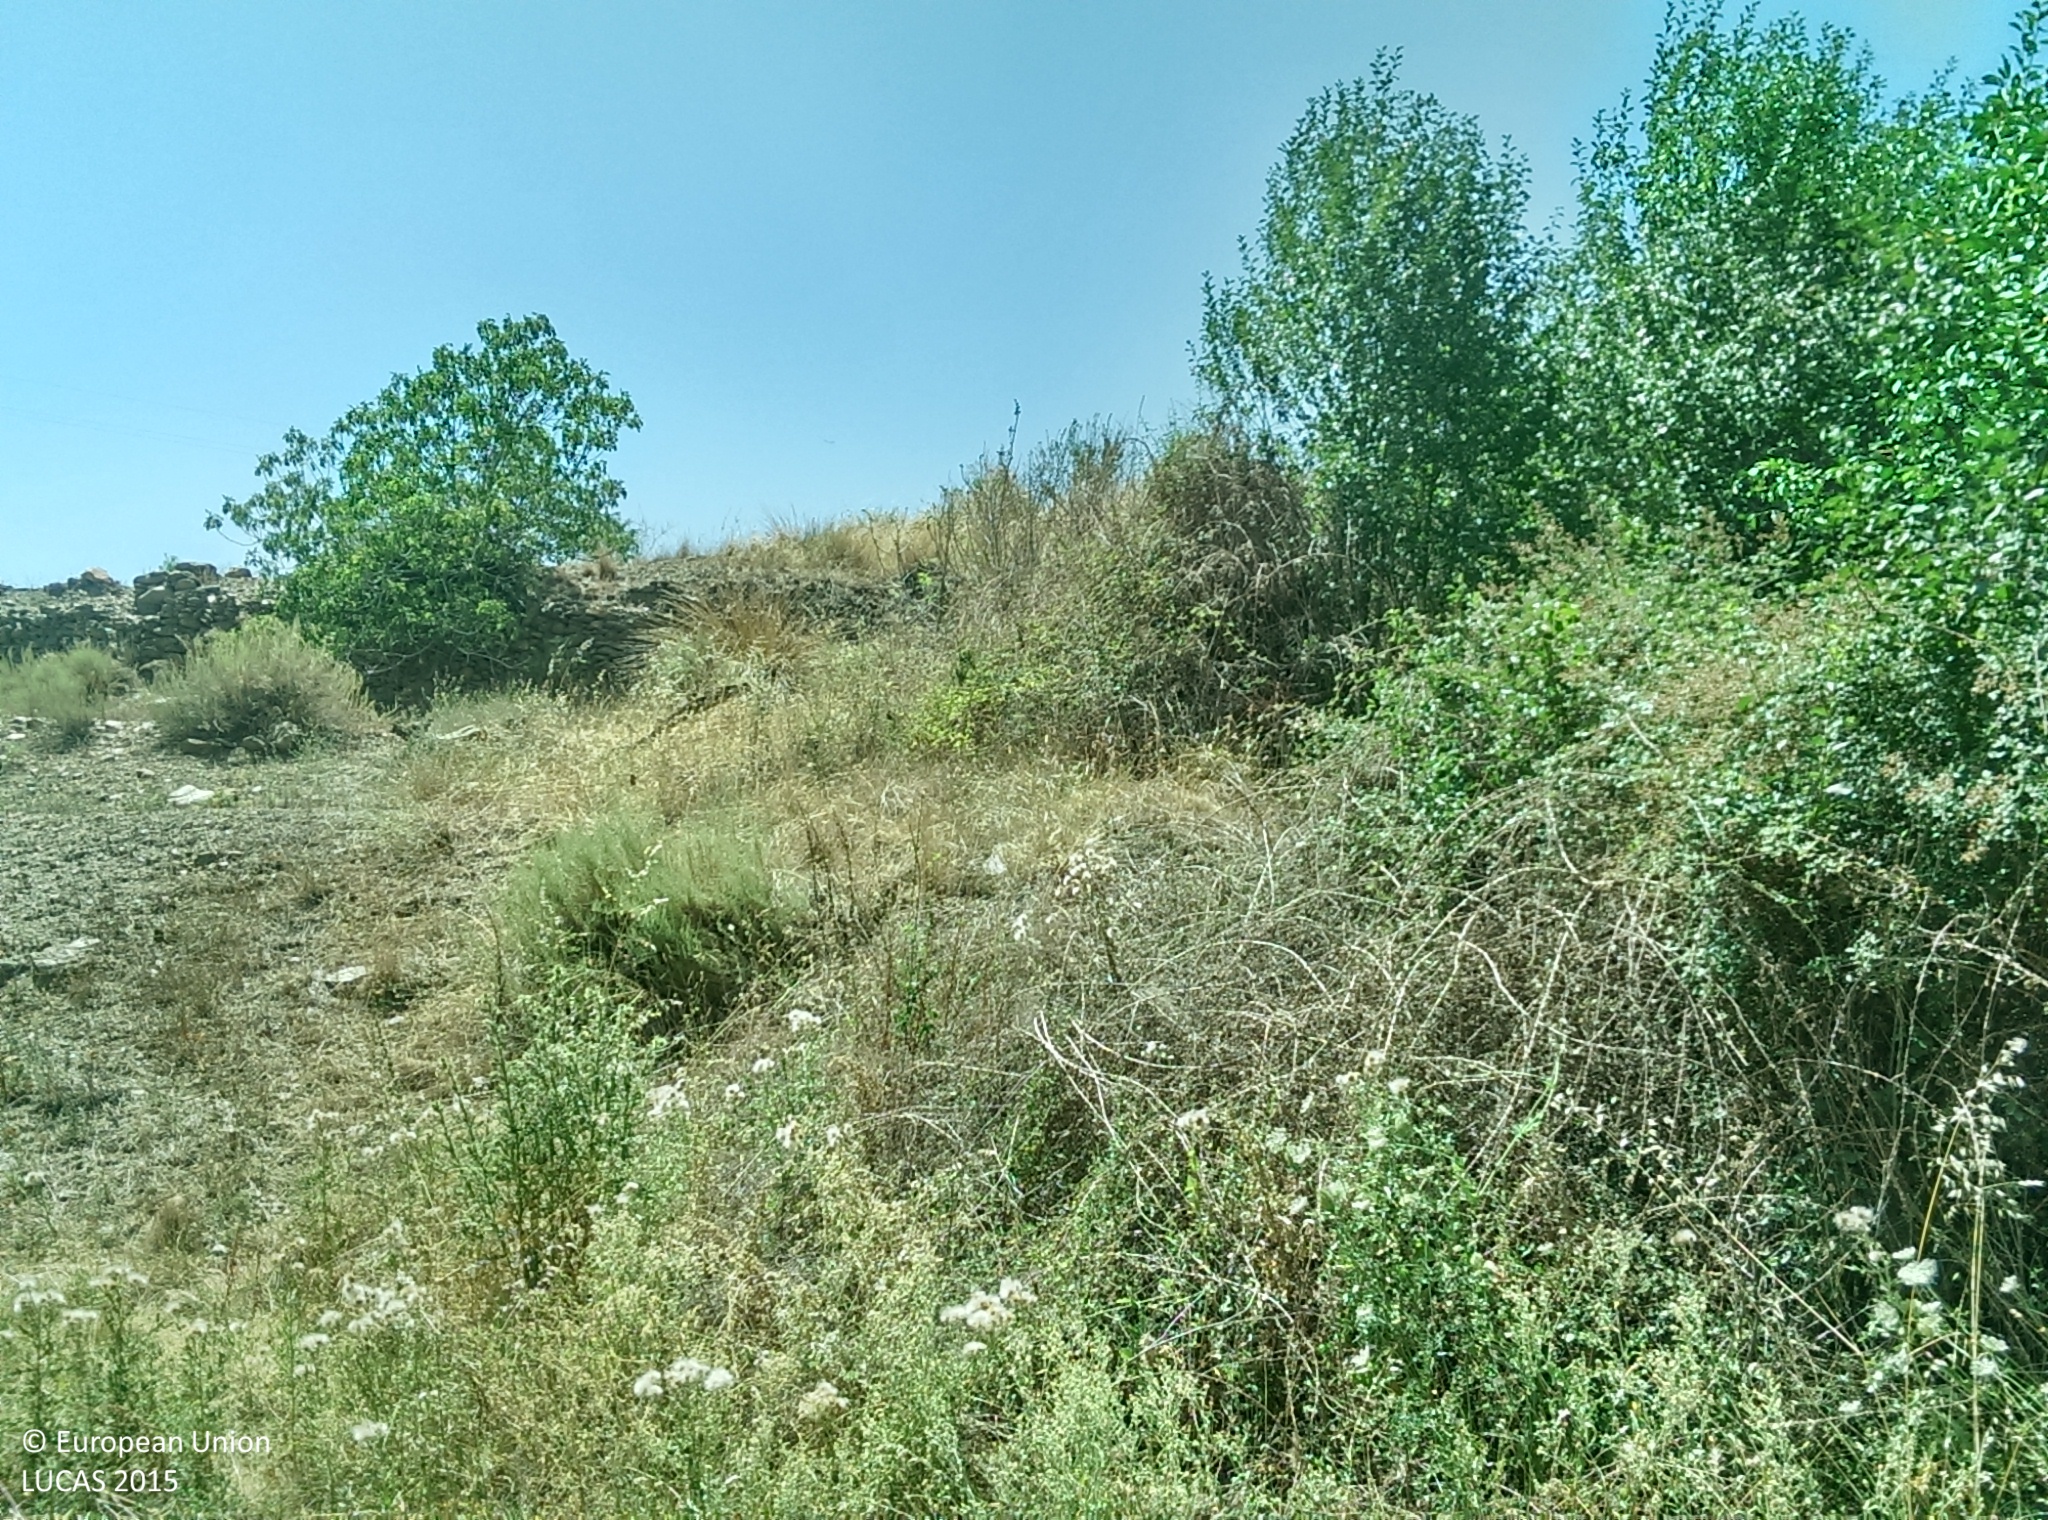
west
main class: Cropland
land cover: Maize
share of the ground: < 10 %
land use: Agriculture (excluding fallow land and kitchen gardens)
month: July
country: ES
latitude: 37.1963
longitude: -3.1556
